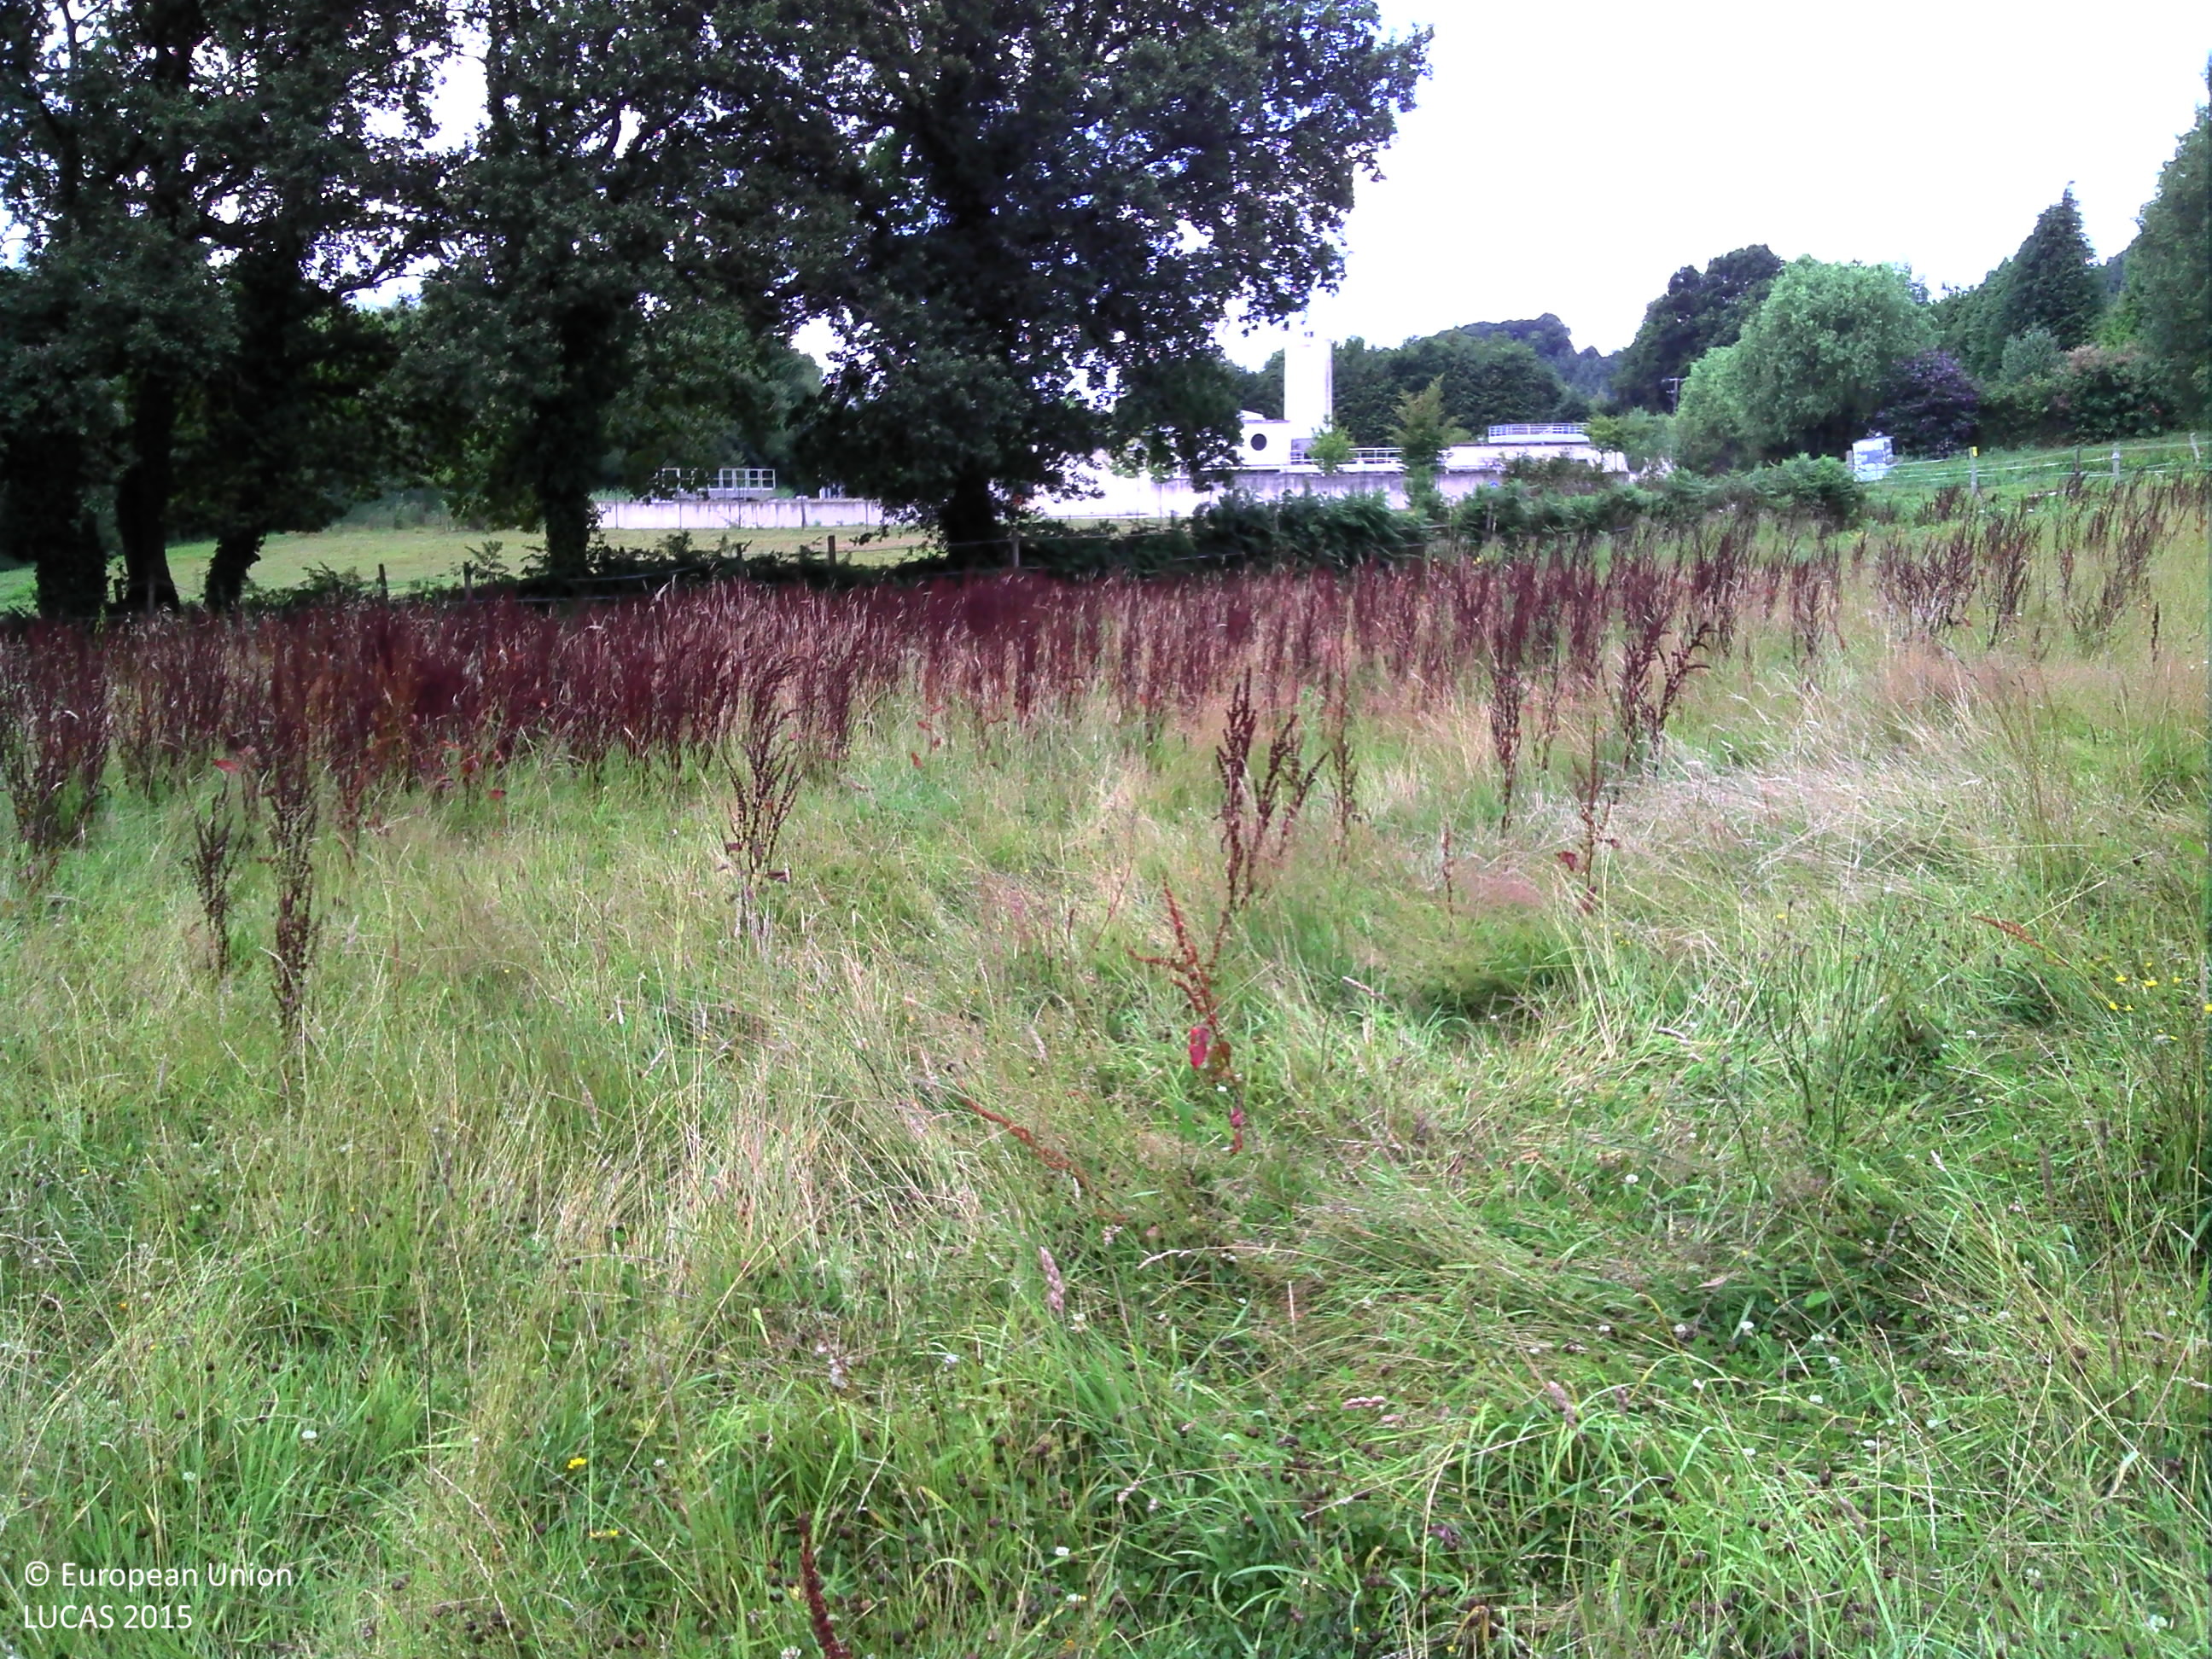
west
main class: Grassland
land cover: Grassland without tree/shrub cover
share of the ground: > 75 %
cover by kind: herbaceous plants 75 %, consolidated bare surface 20 %, shrubs 5 %
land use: Agriculture (excluding fallow land and kitchen gardens)
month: July
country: FR
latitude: 47.8664
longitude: -3.0212
